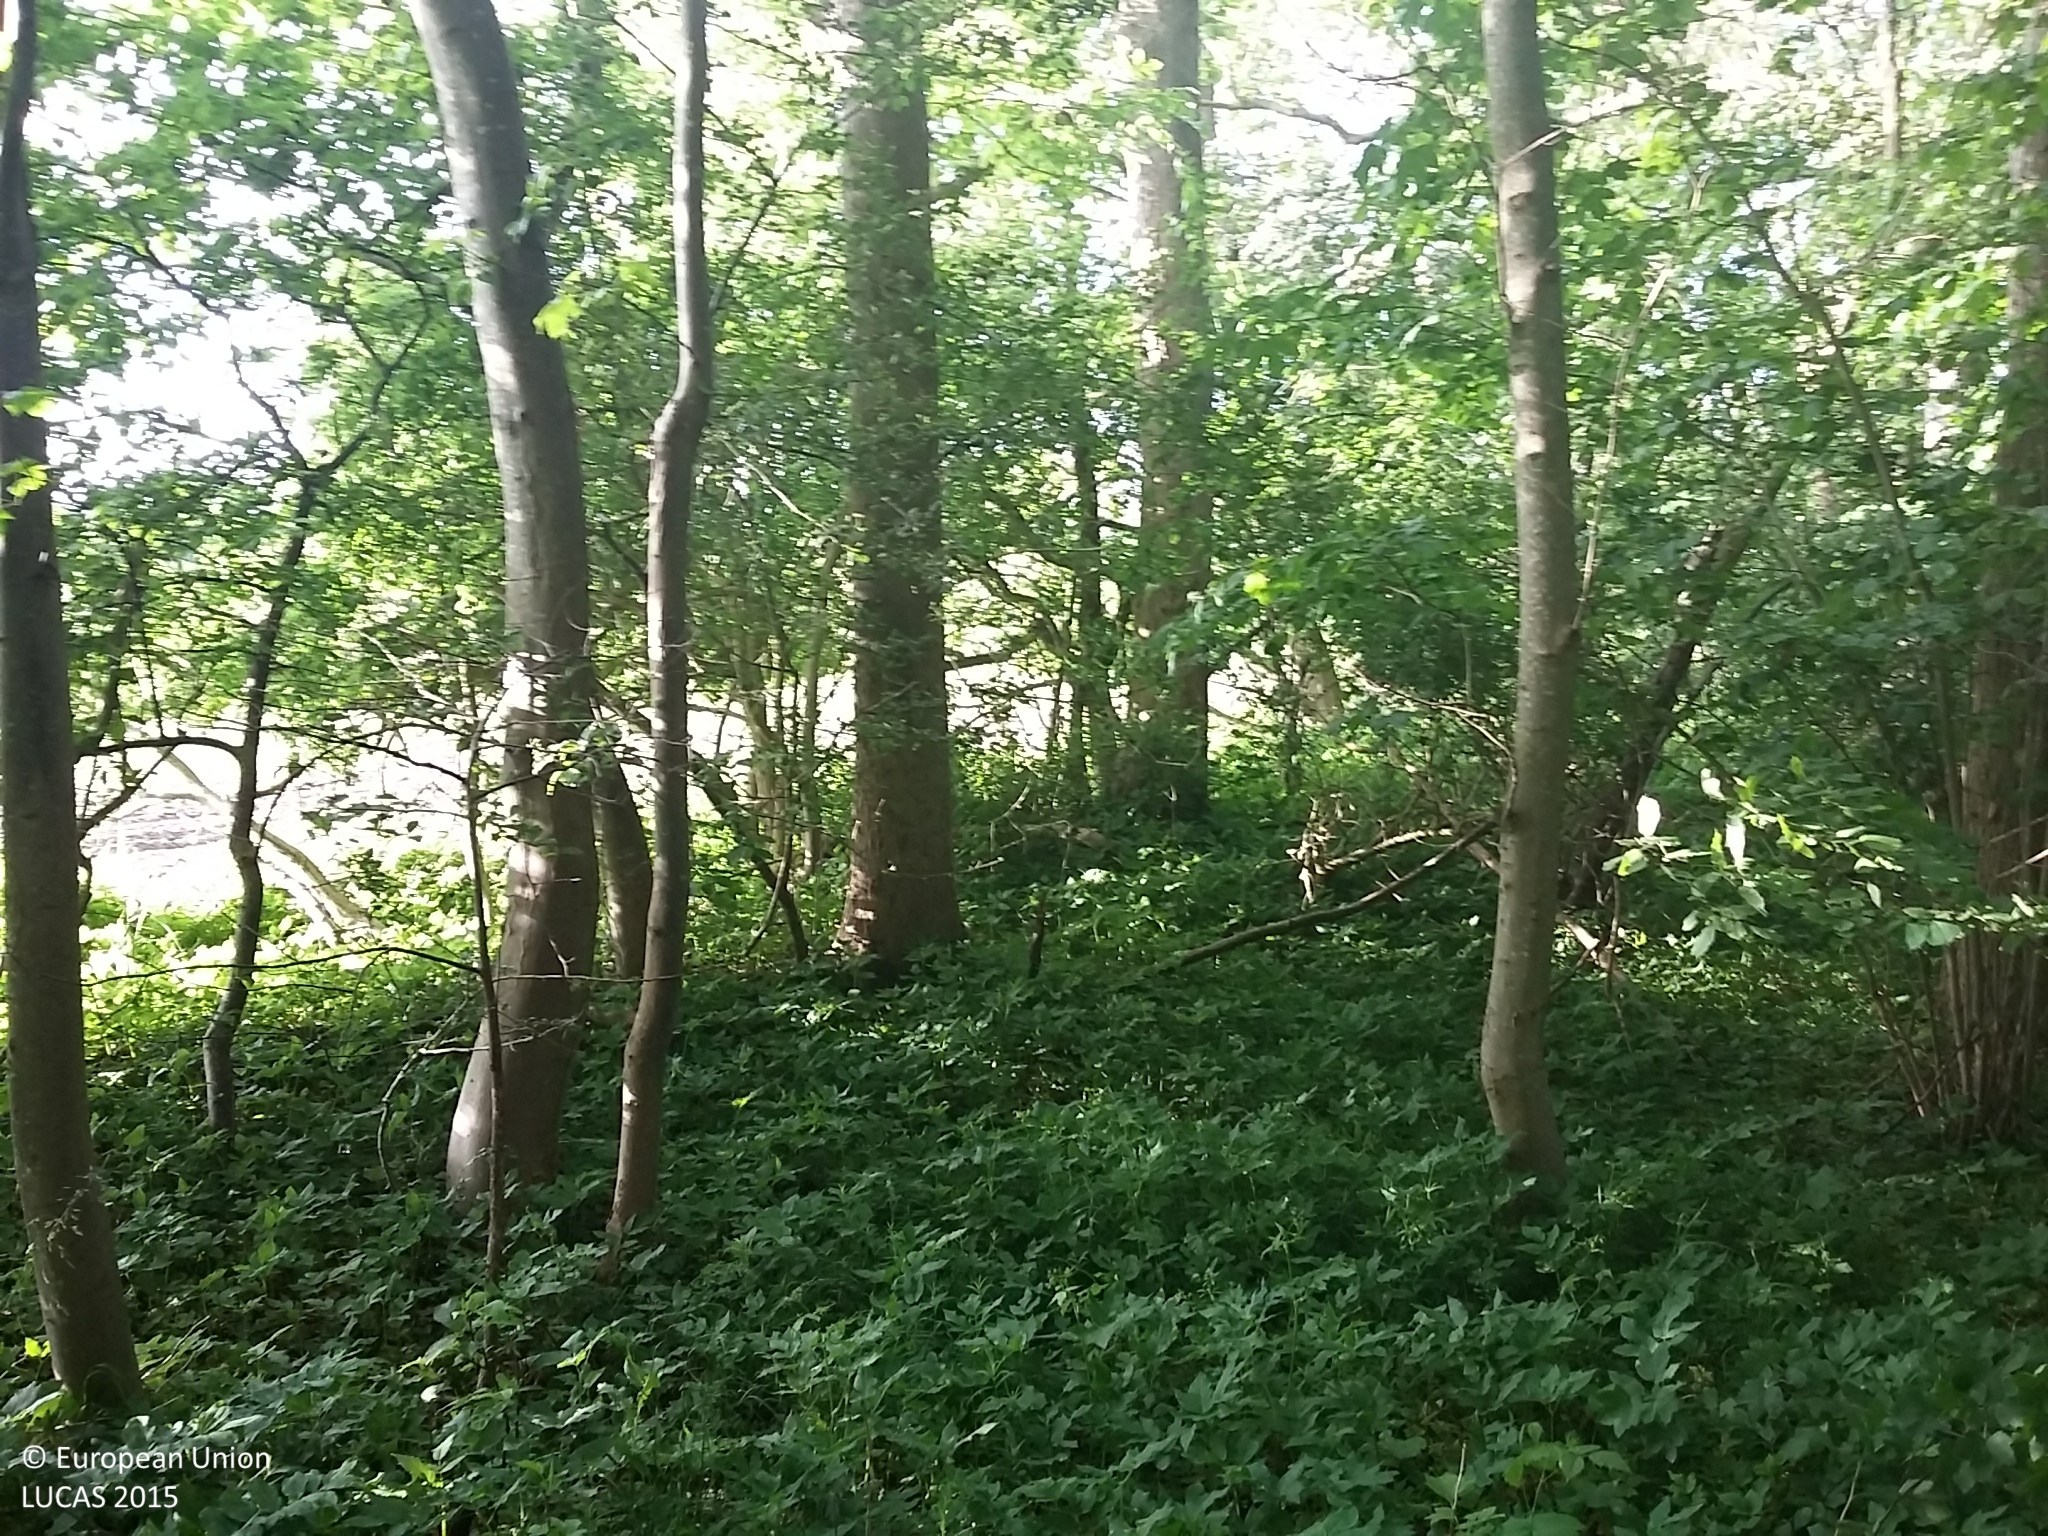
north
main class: Woodland
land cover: Broadleaved woodland
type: beech forest
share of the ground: > 75 %
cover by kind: broadleaved forest trees 85 %, herbaceous plants 15 %
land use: Forestry
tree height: > 5 m
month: June
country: DK
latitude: 55.3774
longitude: 10.6149
